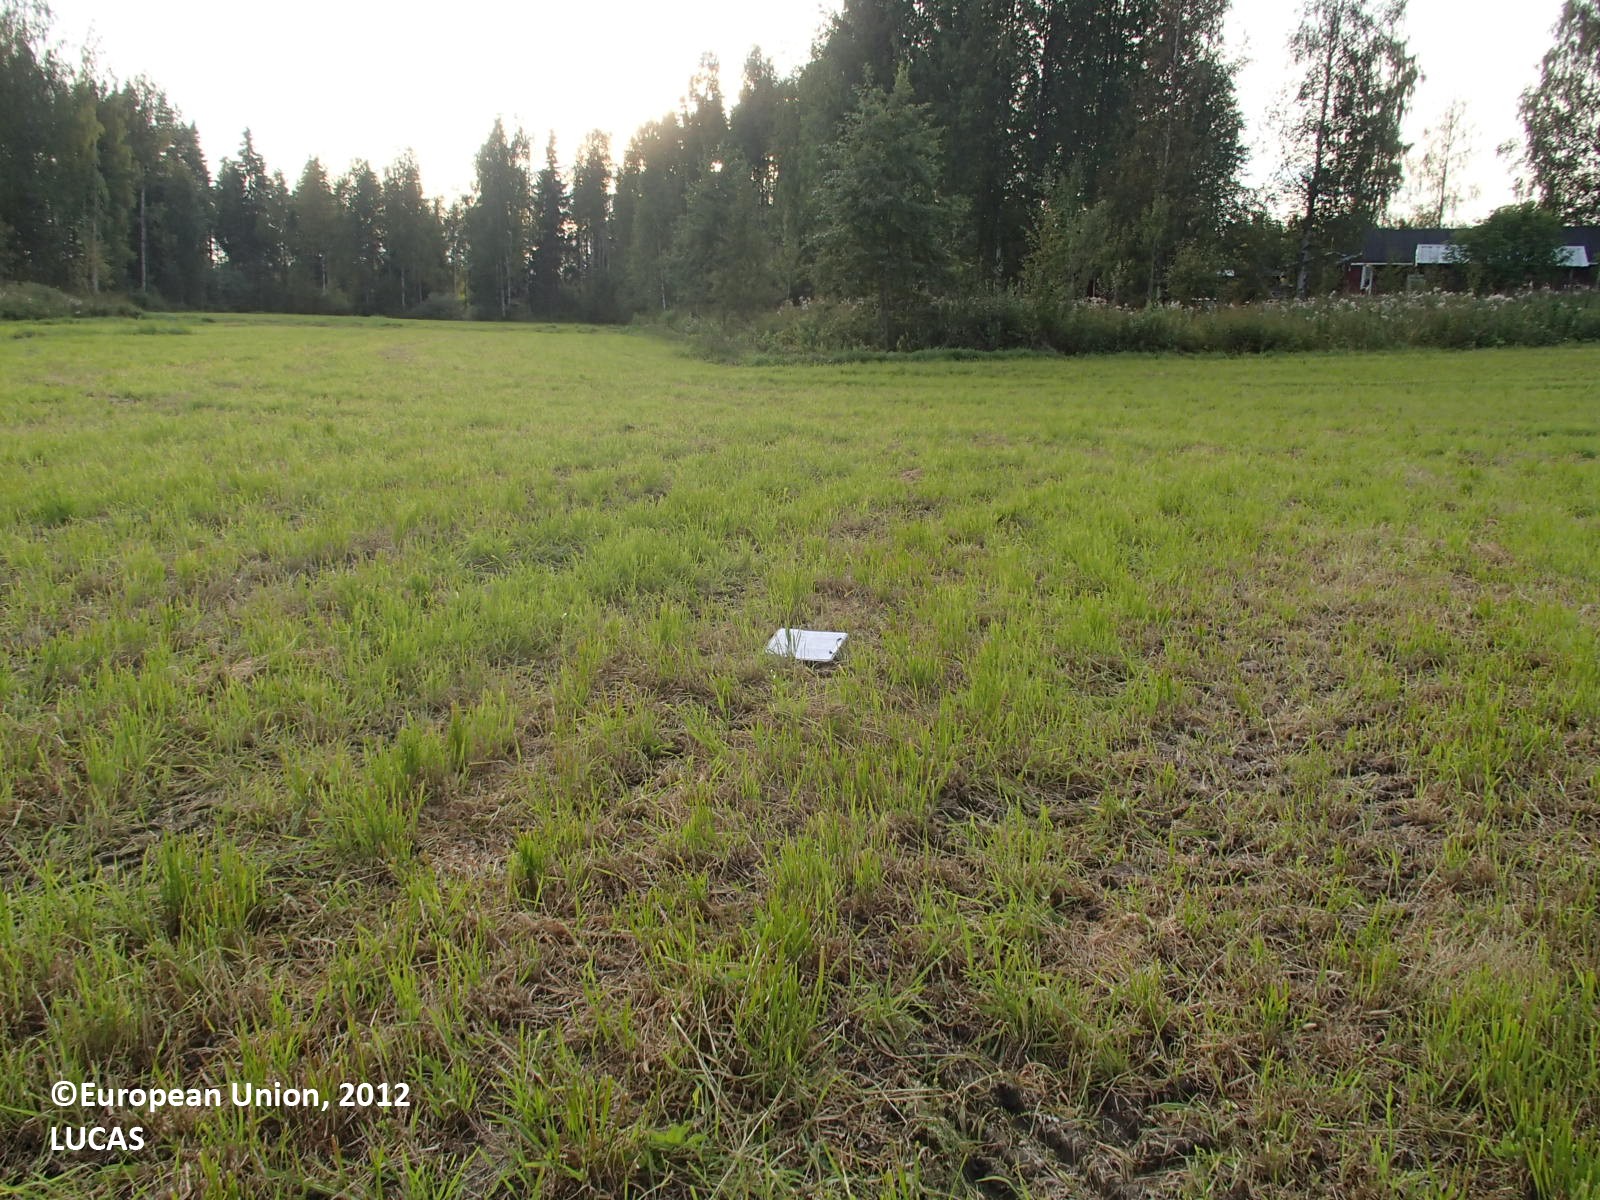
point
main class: Cropland
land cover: Temporary grasslands
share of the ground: > 75 %
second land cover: Barley
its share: < 10 %
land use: Agriculture (excluding fallow land and kitchen gardens)
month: August
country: FI
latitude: 63.3740
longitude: 27.9932
